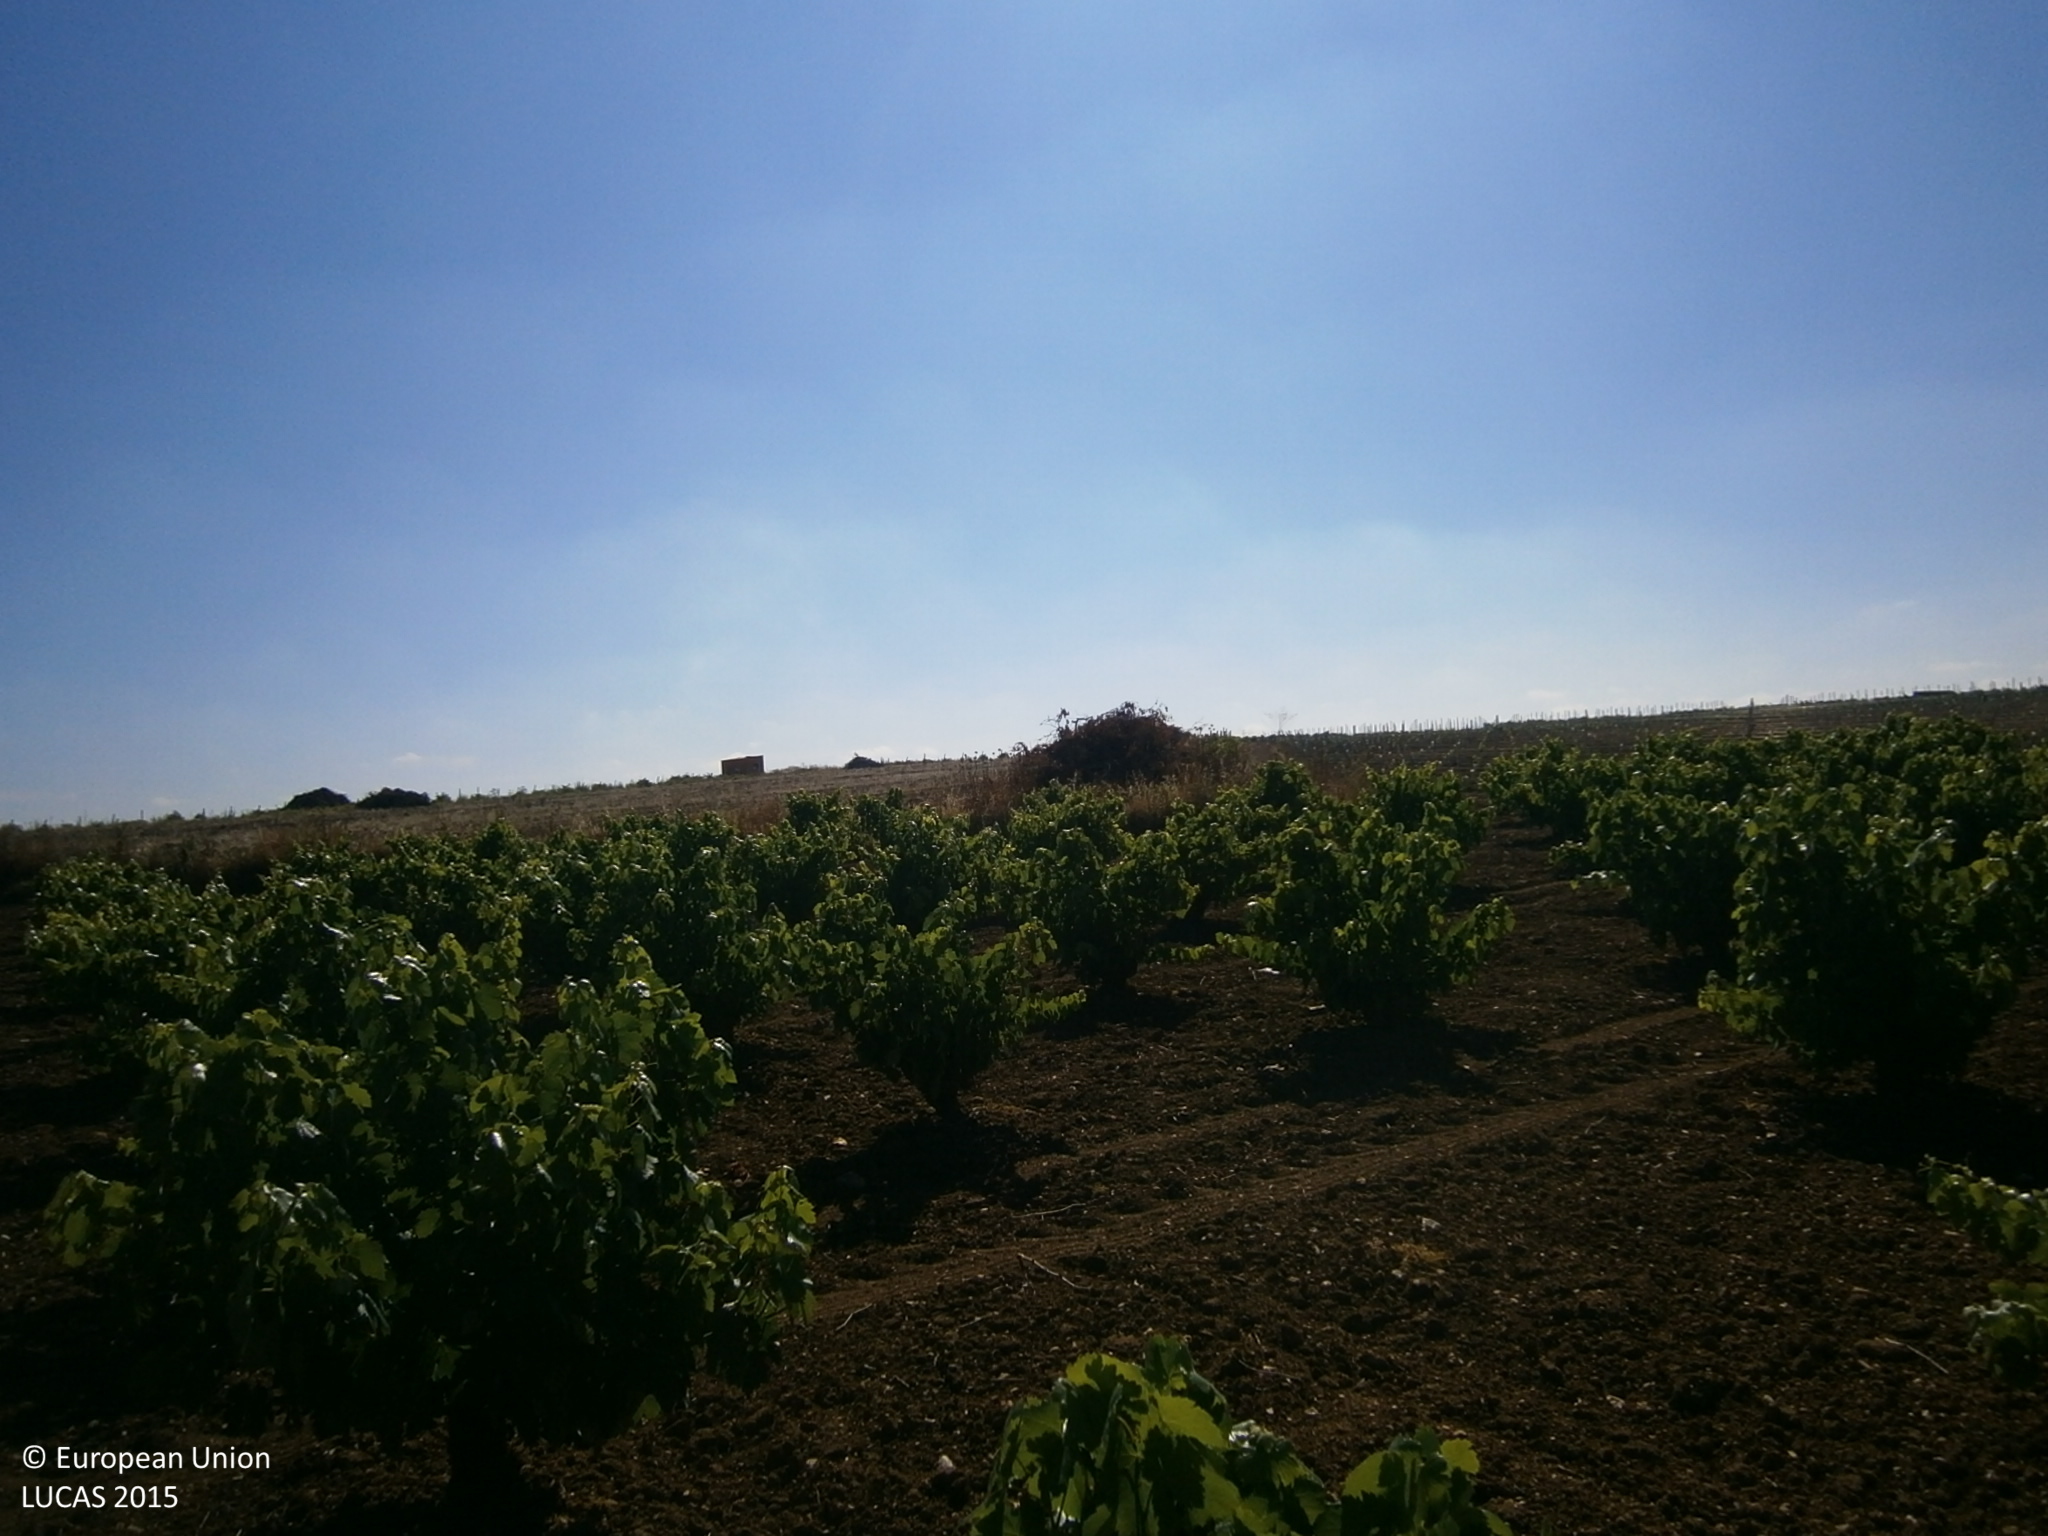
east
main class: Cropland
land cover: Vineyards
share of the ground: 25 - 50 %
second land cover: Other bare soil
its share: > 75 %
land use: Agriculture (excluding fallow land and kitchen gardens)
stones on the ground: < 10 %
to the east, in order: Vineyards; Other bare soil; Grass margins; Grassland without tree/shrub cover
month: June
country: ES
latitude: 38.6860
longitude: -6.4373
